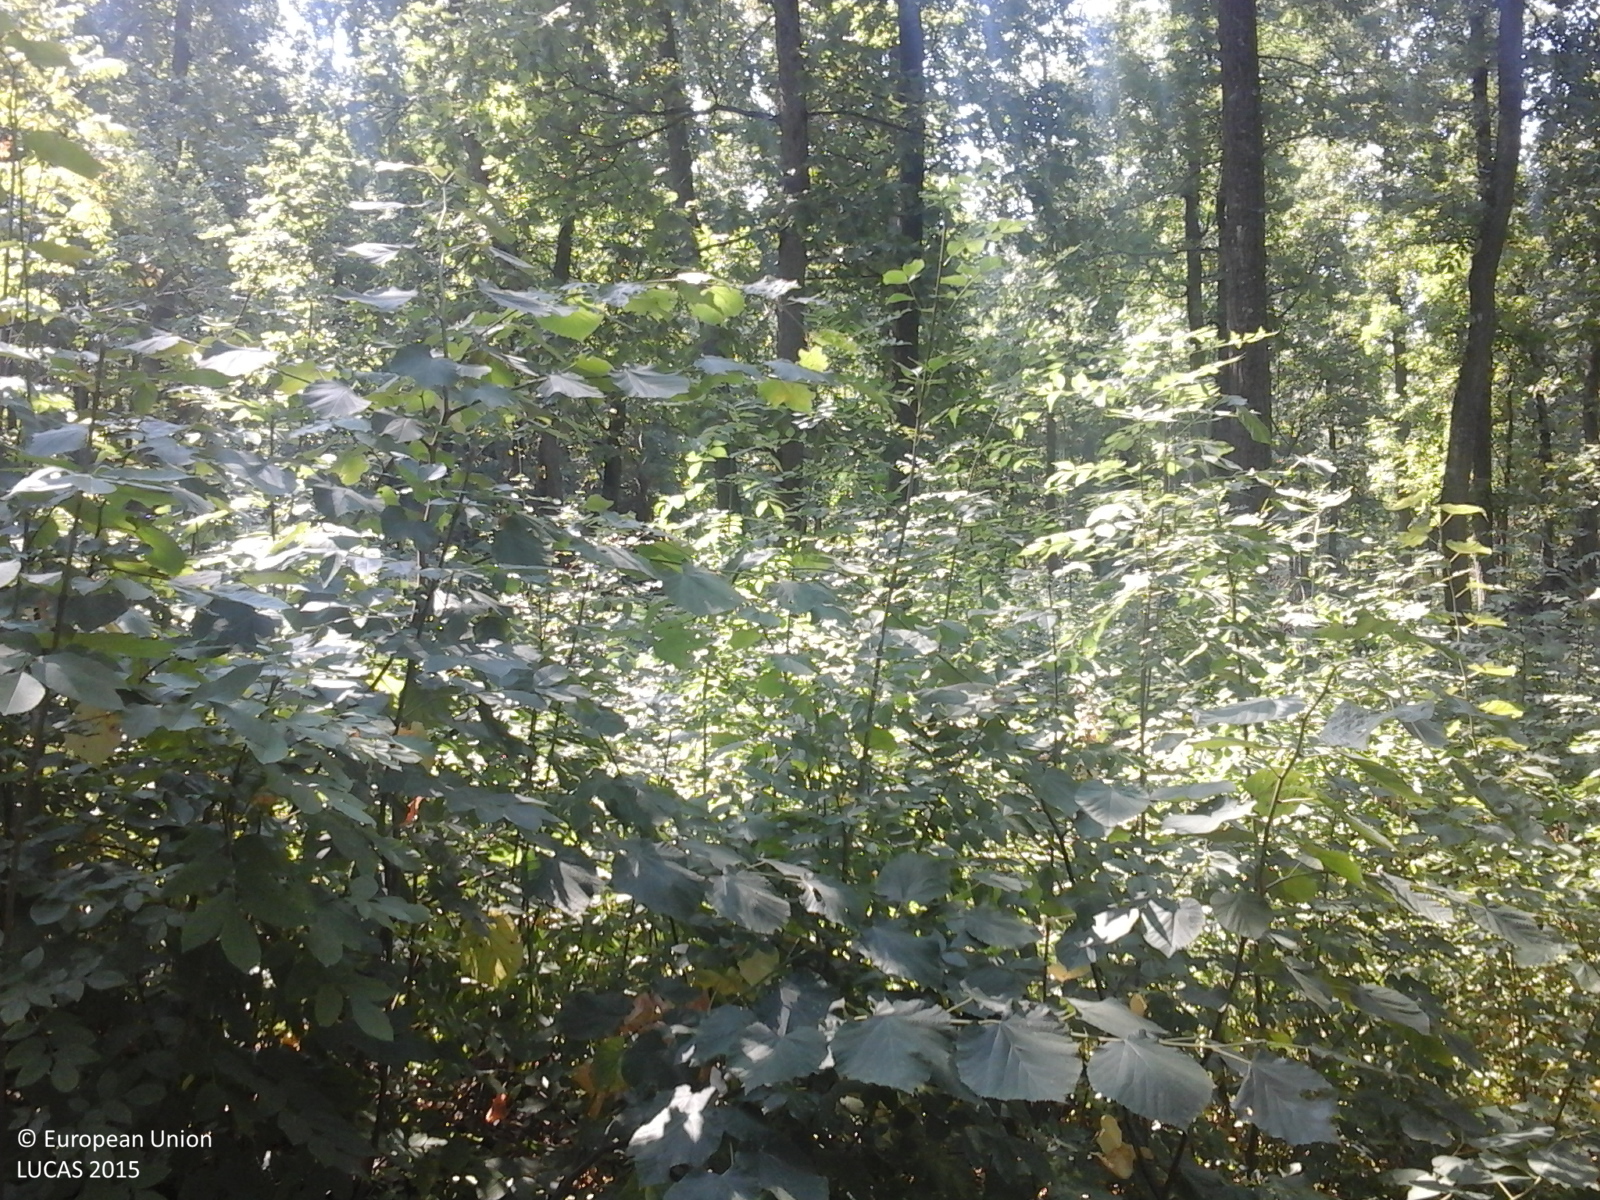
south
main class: Woodland
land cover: Broadleaved woodland
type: acidophilous oak and oak-birch forest
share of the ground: > 75 %
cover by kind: broadleaved forest trees 100 %
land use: Forestry
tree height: > 5 m
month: August
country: RO
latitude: 44.5497
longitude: 23.1520
